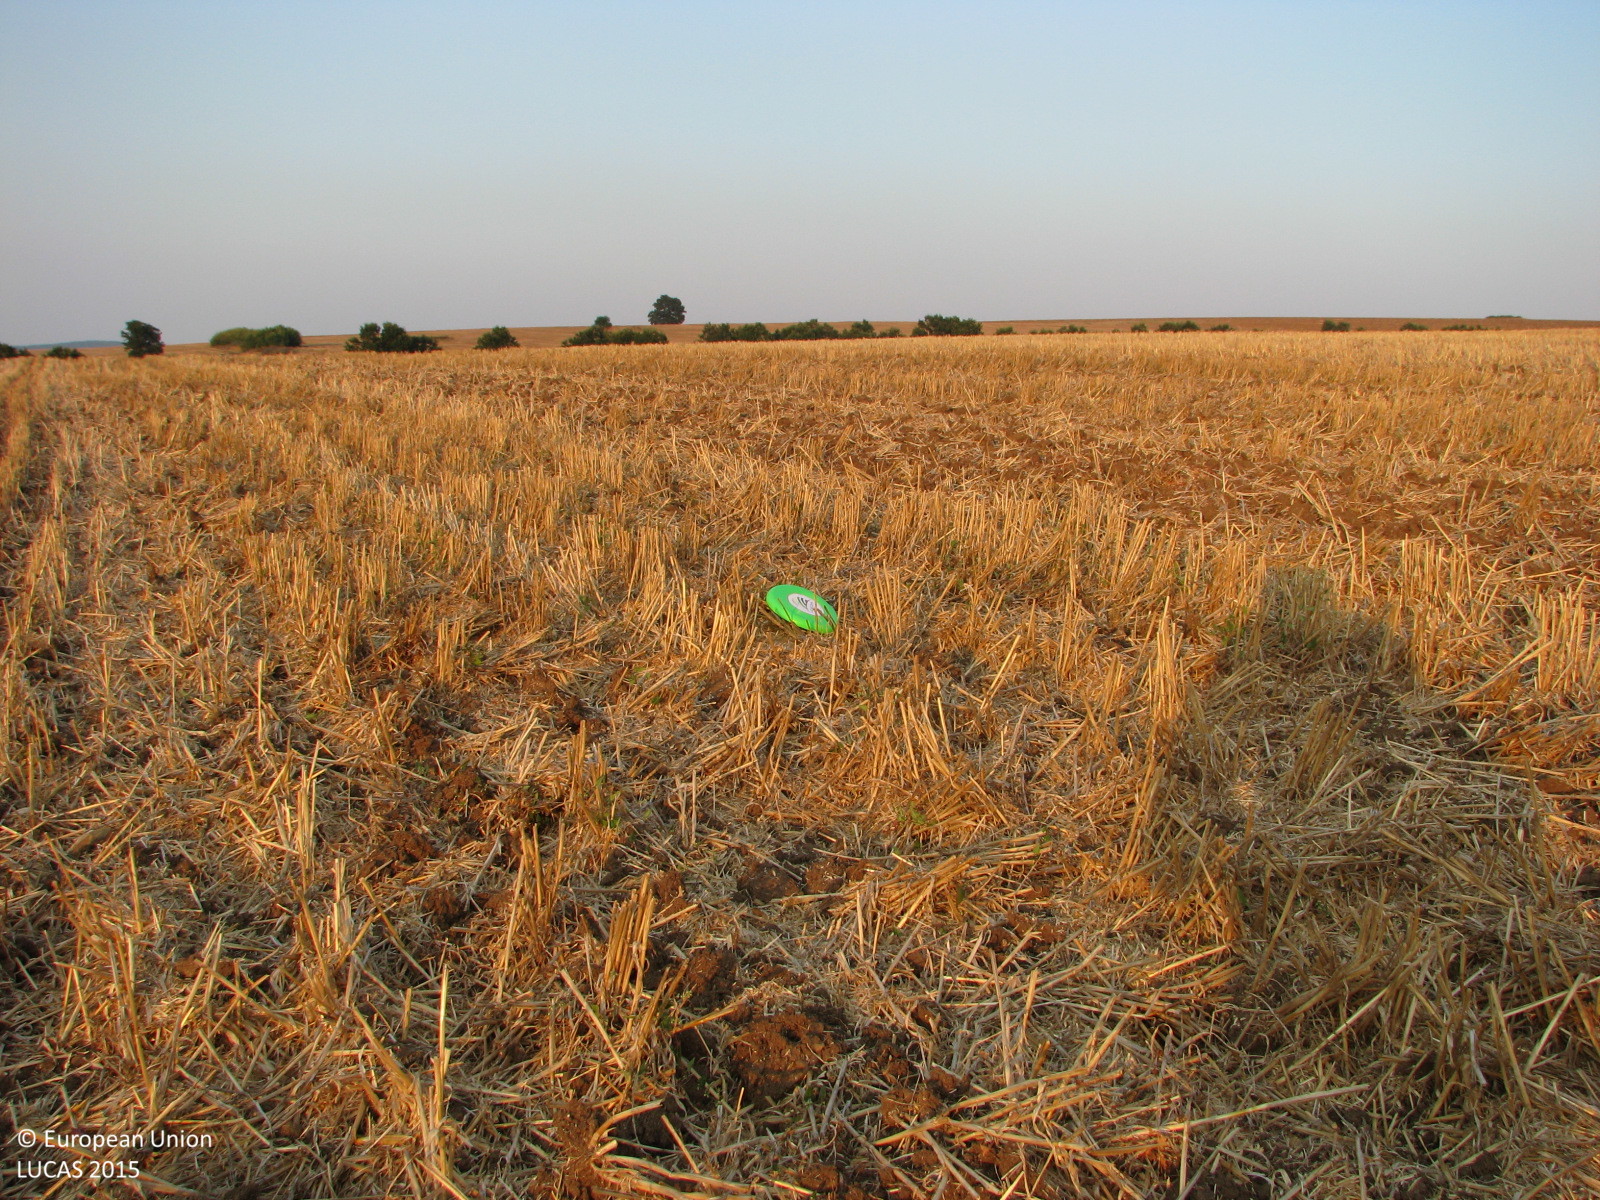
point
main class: Cropland
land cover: Common wheat
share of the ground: 25 - 50 %
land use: Agriculture (excluding fallow land and kitchen gardens)
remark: Harvested field
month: August
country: BG
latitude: 42.1808
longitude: 26.8901
